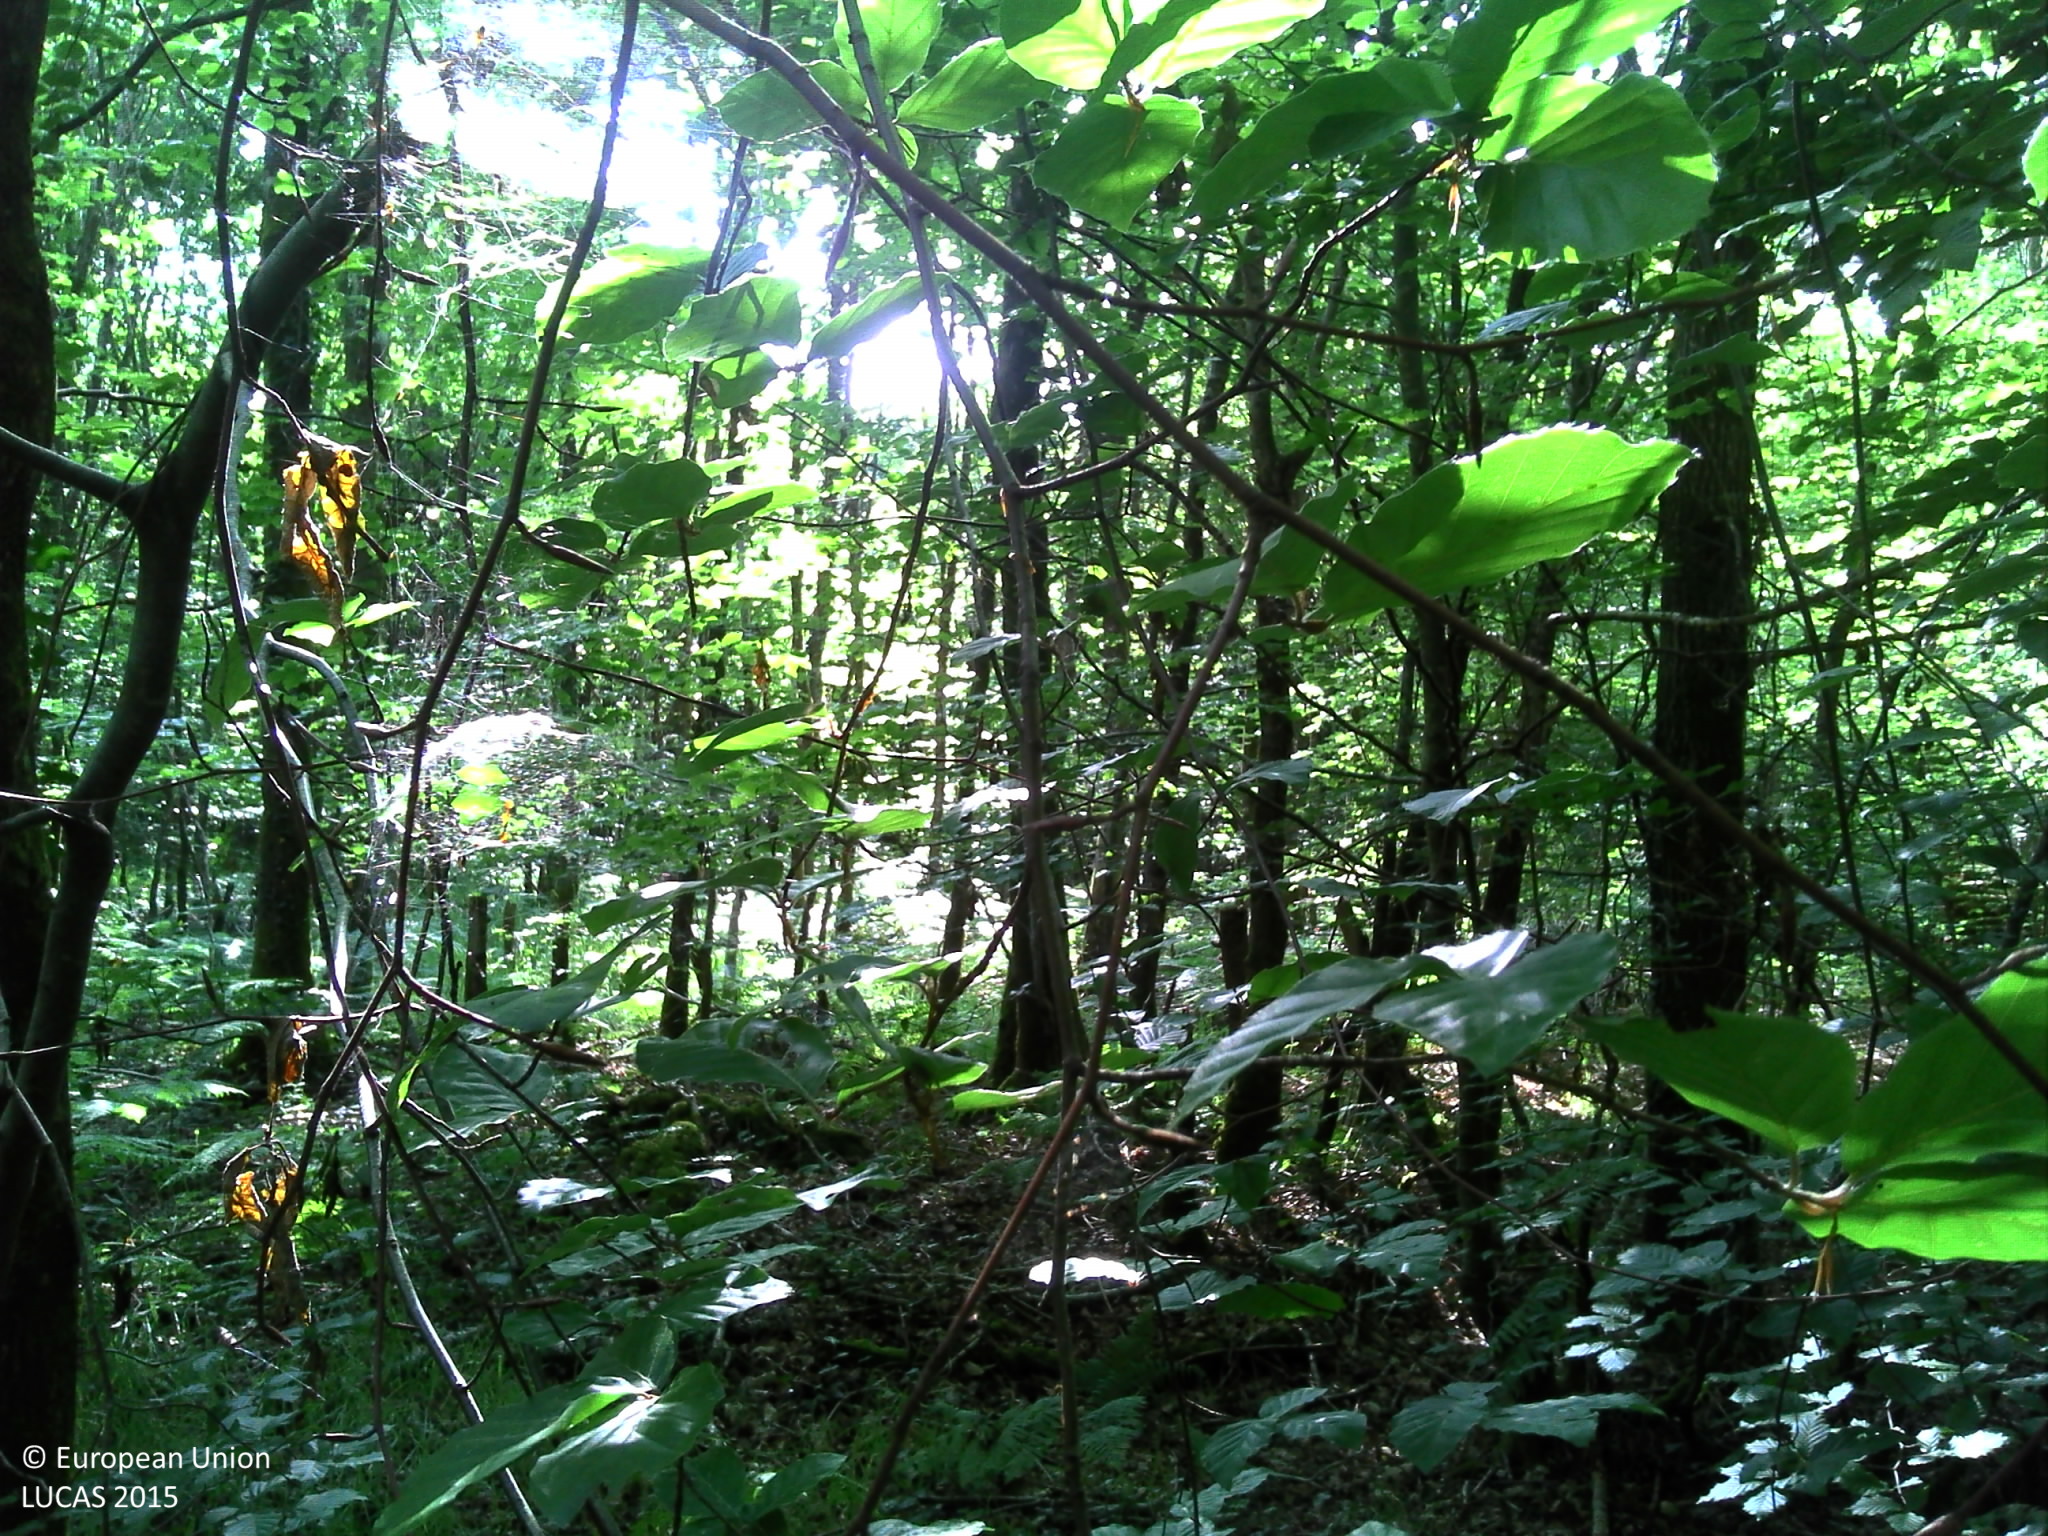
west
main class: Woodland
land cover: Broadleaved woodland
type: beech forest
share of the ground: > 75 %
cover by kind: broadleaved forest trees 75 %, herbaceous plants 15 %, shrubs 10 %
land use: Forestry
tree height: > 5 m
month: June
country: FR
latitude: 48.4051
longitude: 0.2333
